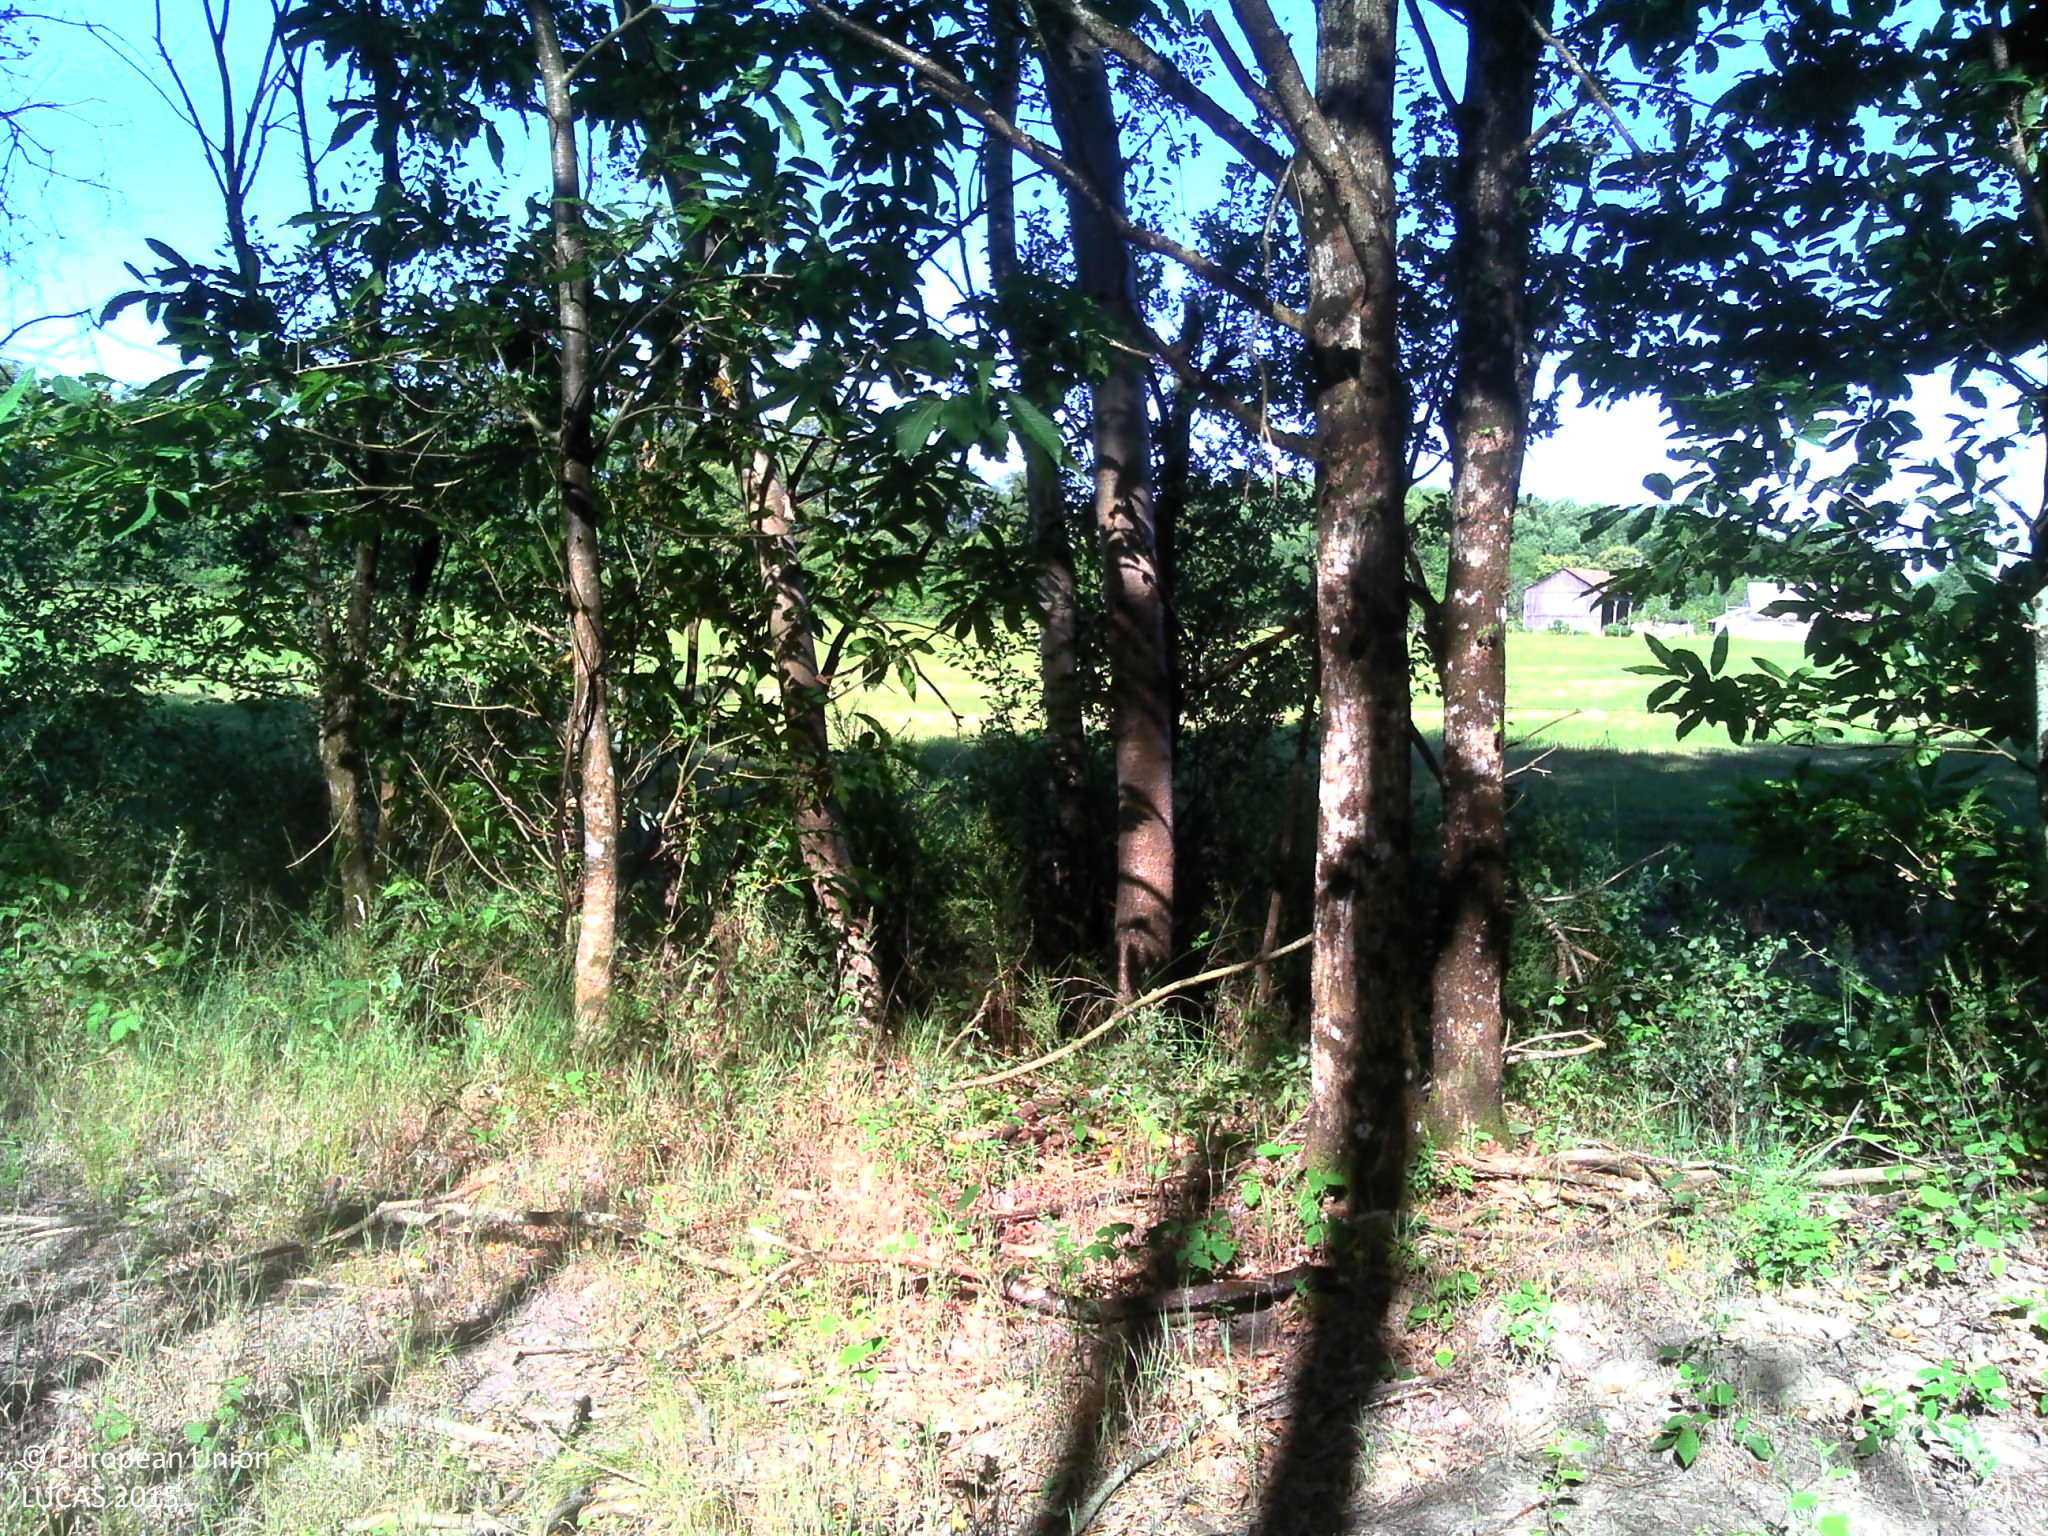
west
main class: Woodland
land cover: Broadleaved woodland
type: mesophytic deciduous forest
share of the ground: > 75 %
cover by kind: broadleaved forest trees 75 %, shrubs 10 %, coniferous forest trees 5 %, herbaceous plants 5 %, lichens and mosses 5 %
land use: Forestry
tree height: > 5 m
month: June
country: FR
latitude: 47.4001
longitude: 0.3447
